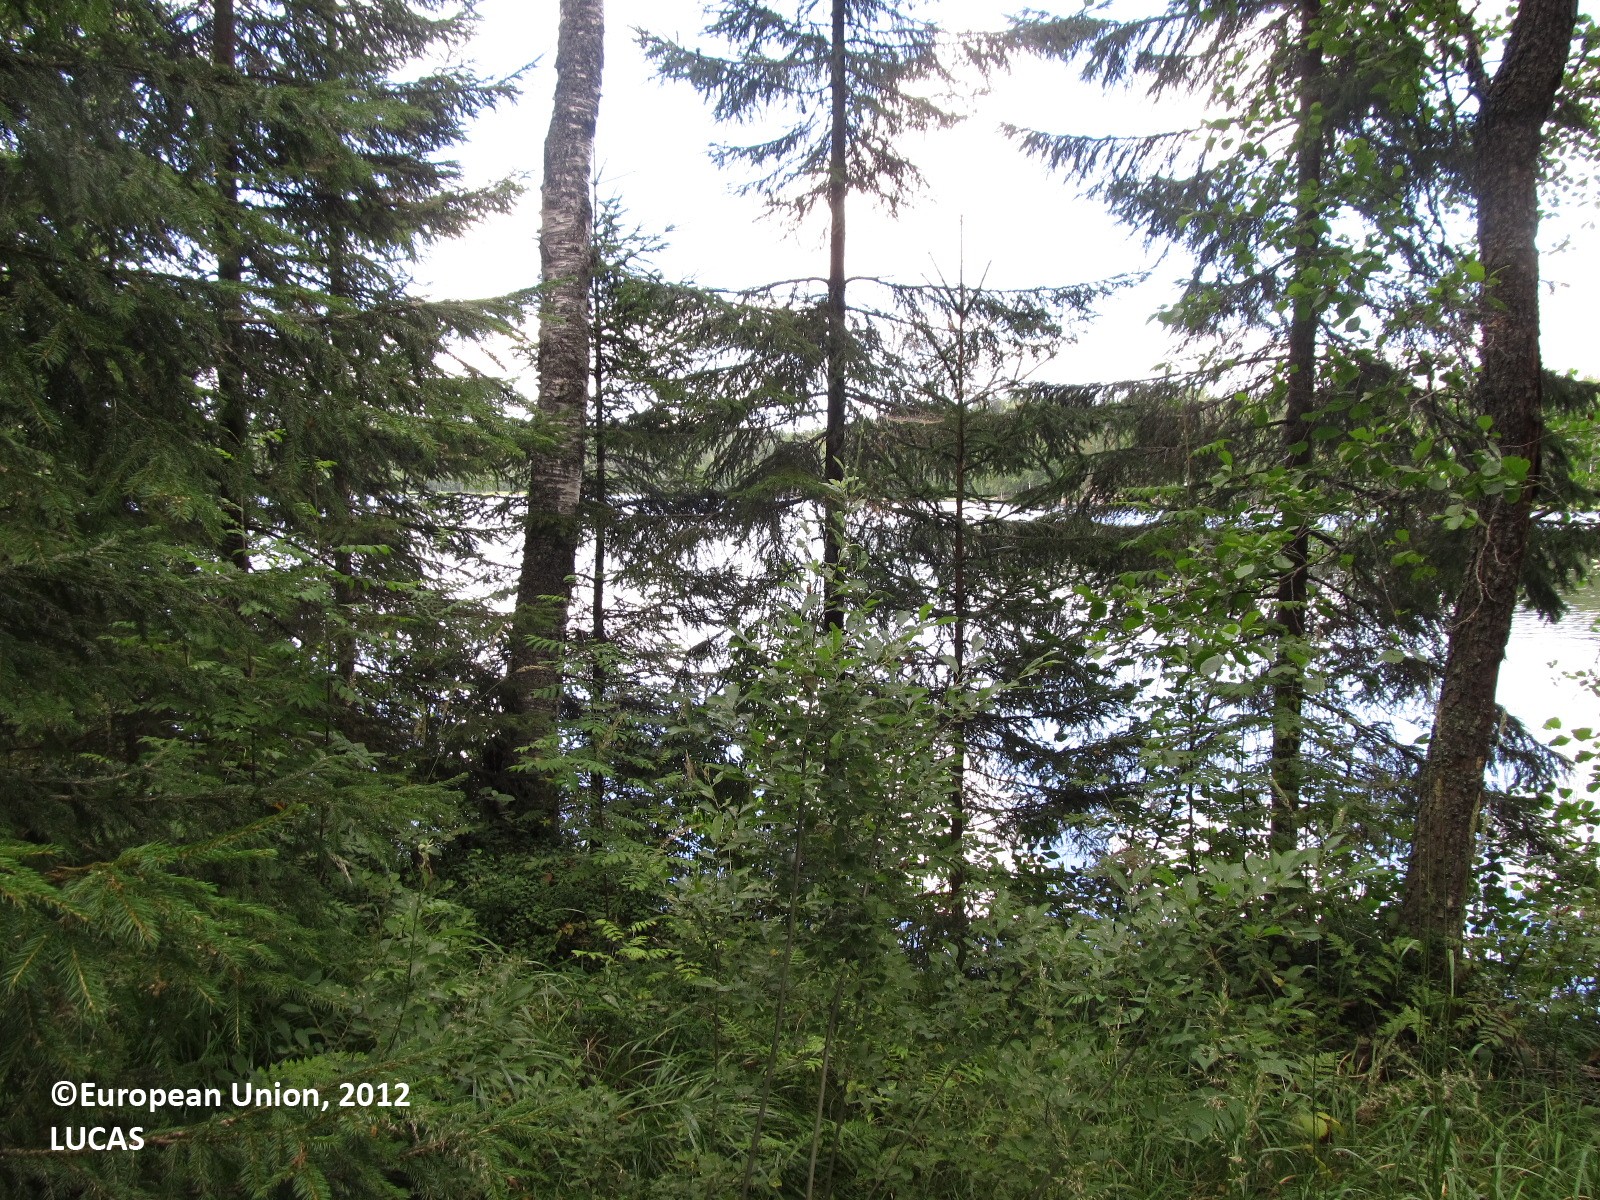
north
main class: Woodland
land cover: Spruce dominated mixed woodland
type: boreal forest
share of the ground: 50 - 75 %
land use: Forestry
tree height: > 5 m
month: August
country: FI
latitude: 61.7922
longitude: 27.8422
